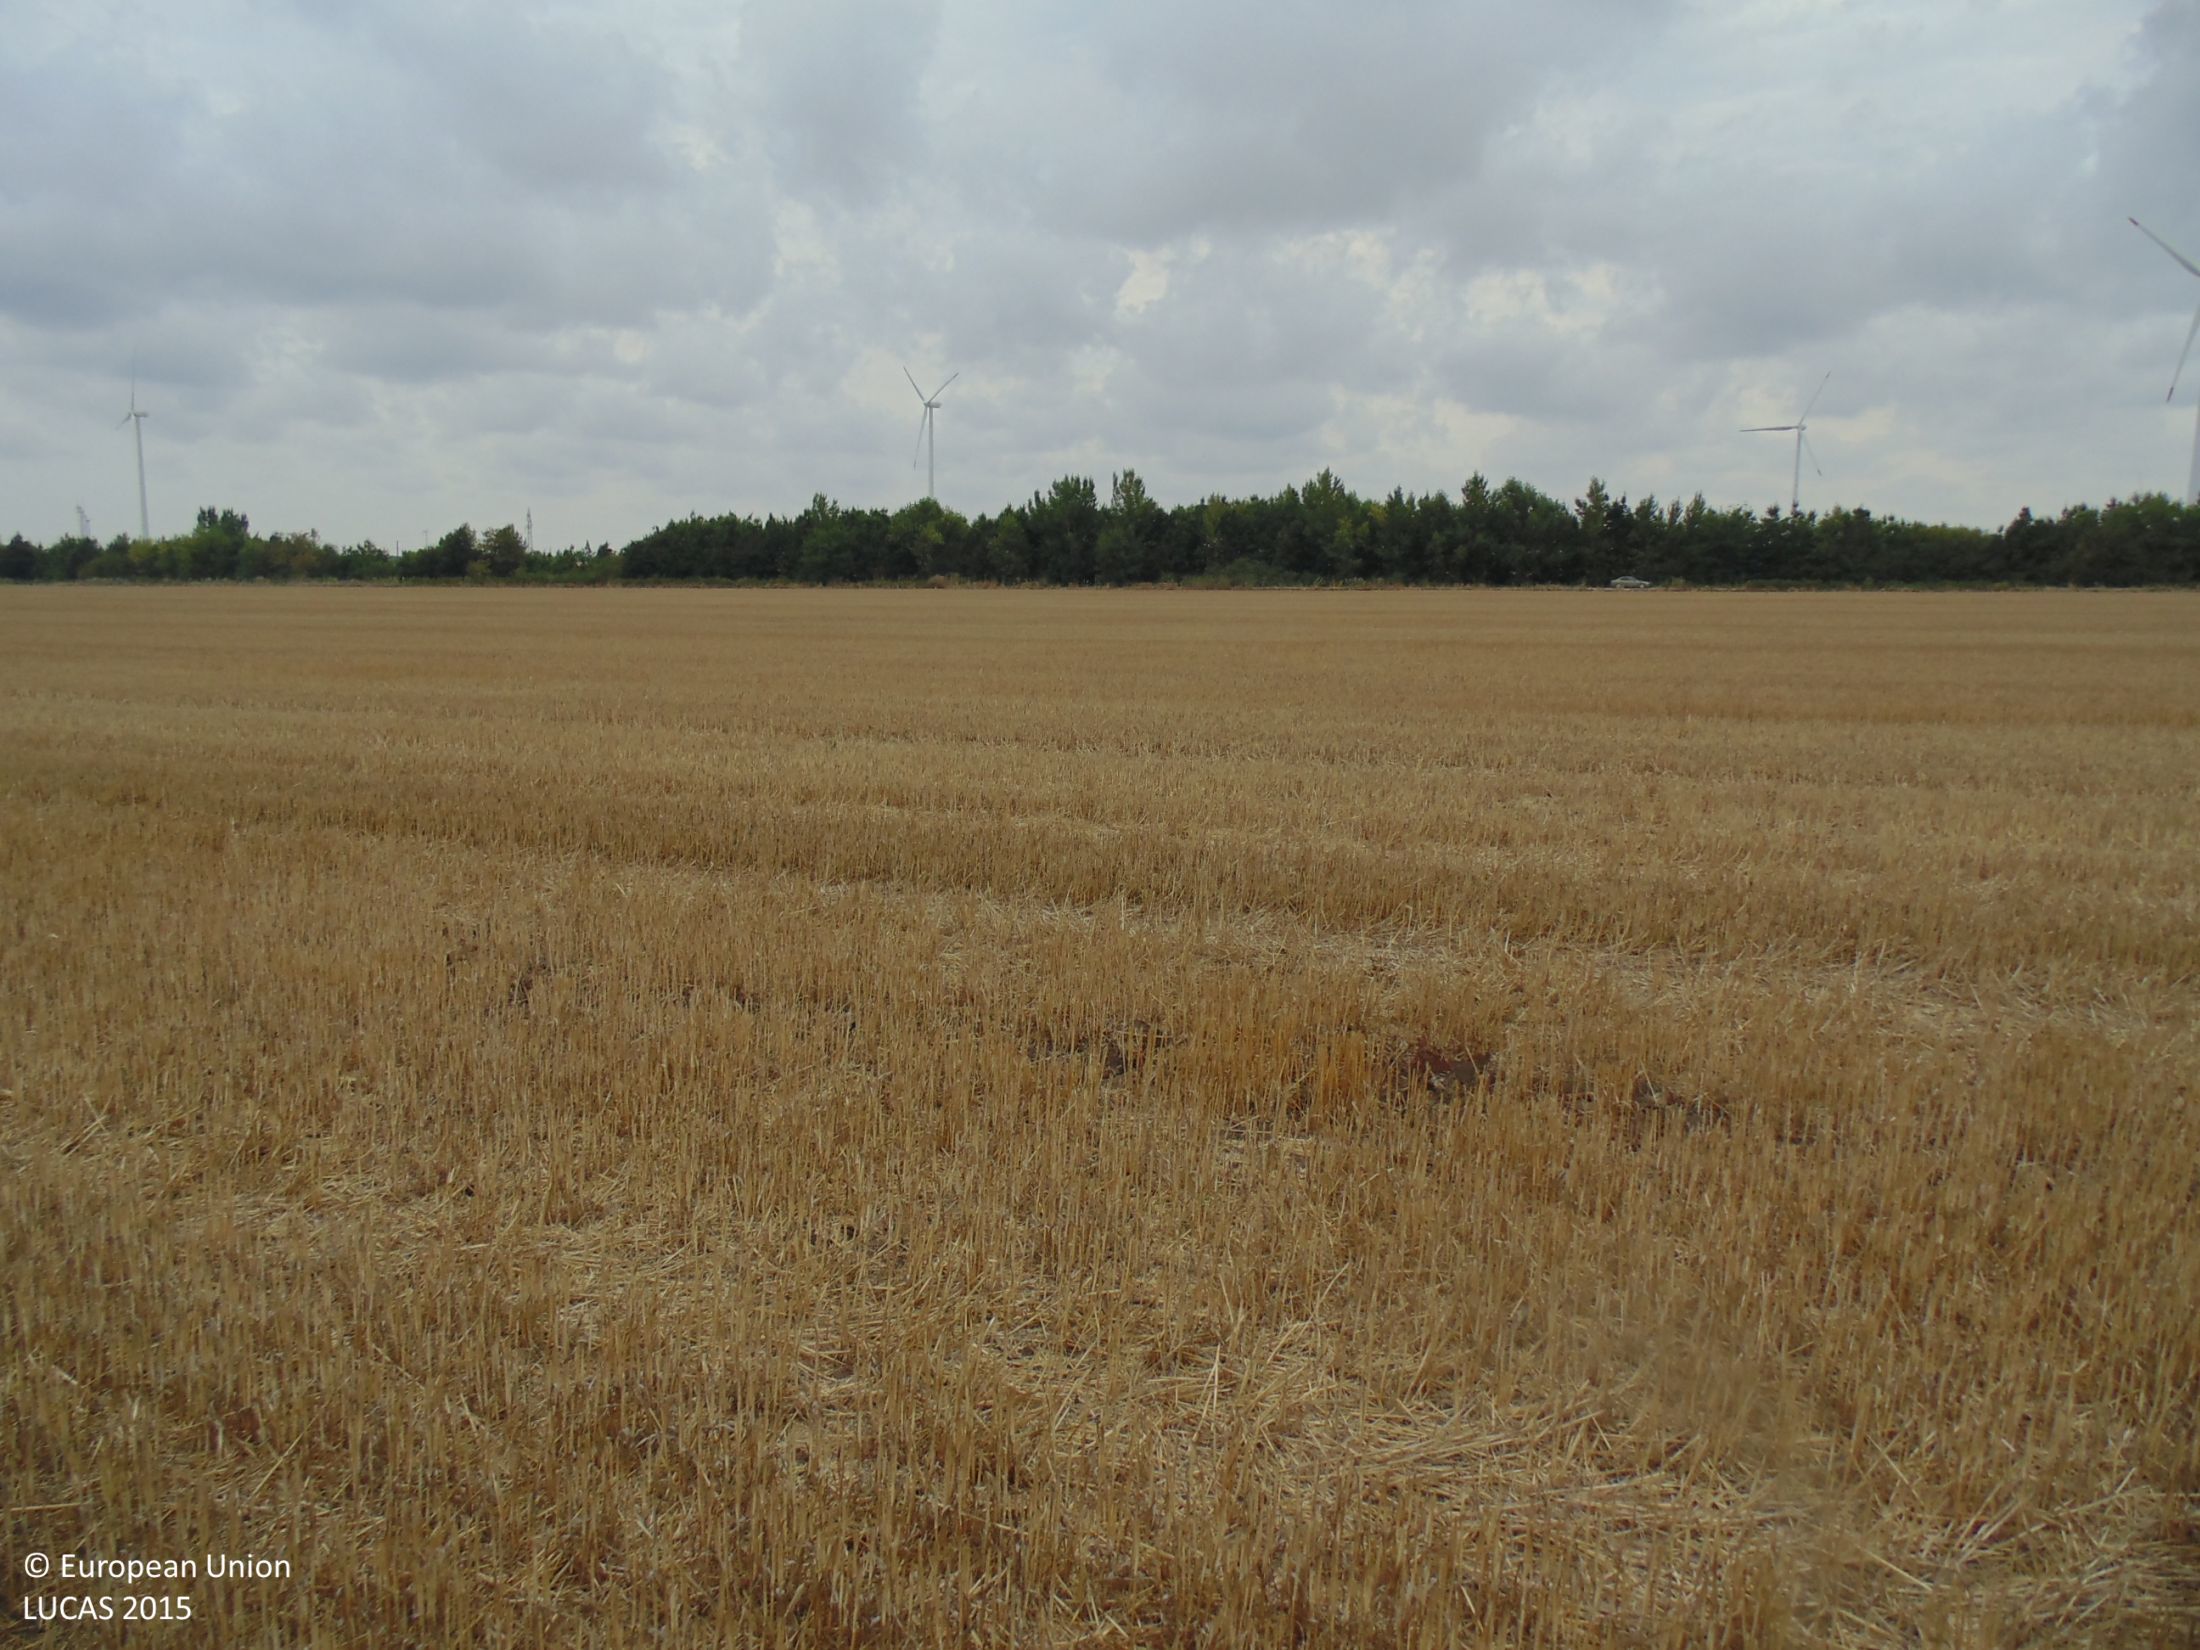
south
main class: Cropland
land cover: Common wheat
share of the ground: 25 - 50 %
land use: Agriculture (excluding fallow land and kitchen gardens)
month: August
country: BG
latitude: 43.5565
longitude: 28.4949
